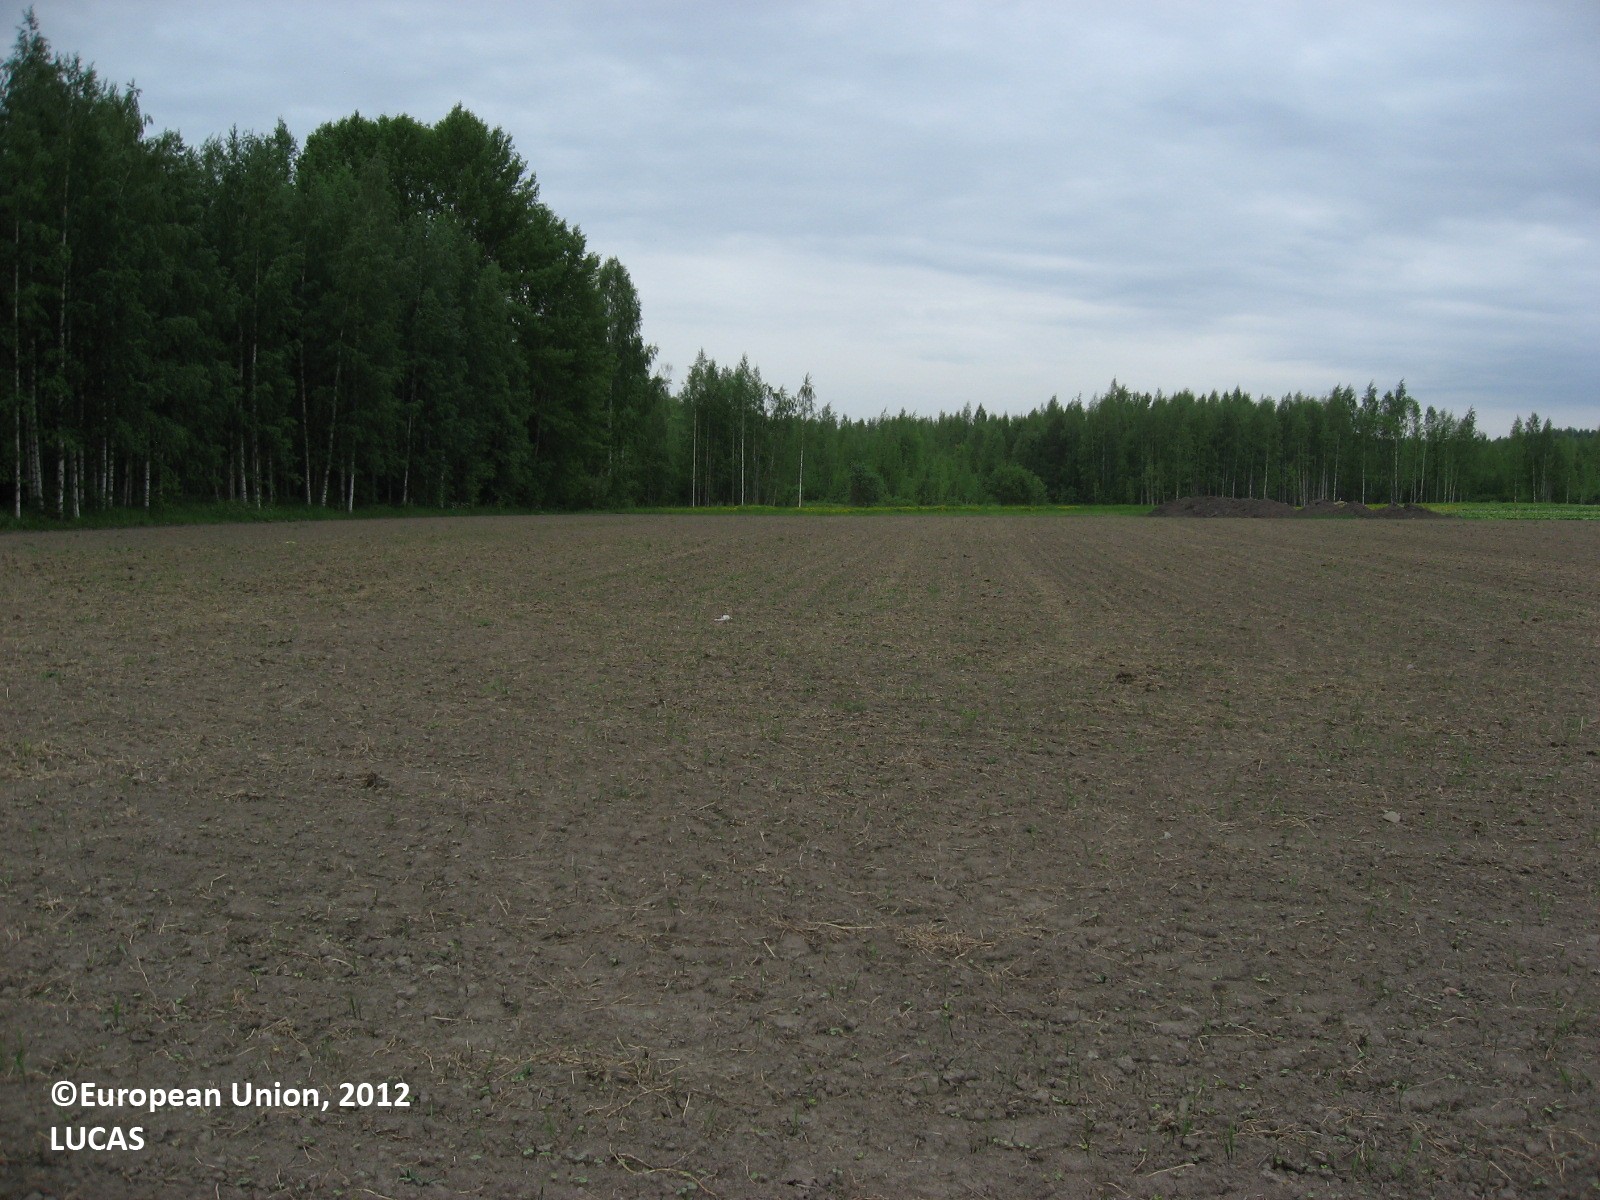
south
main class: Cropland
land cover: Other cereals
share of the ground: < 10 %
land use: Agriculture (excluding fallow land and kitchen gardens)
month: June
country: FI
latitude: 60.4202
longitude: 24.9916
